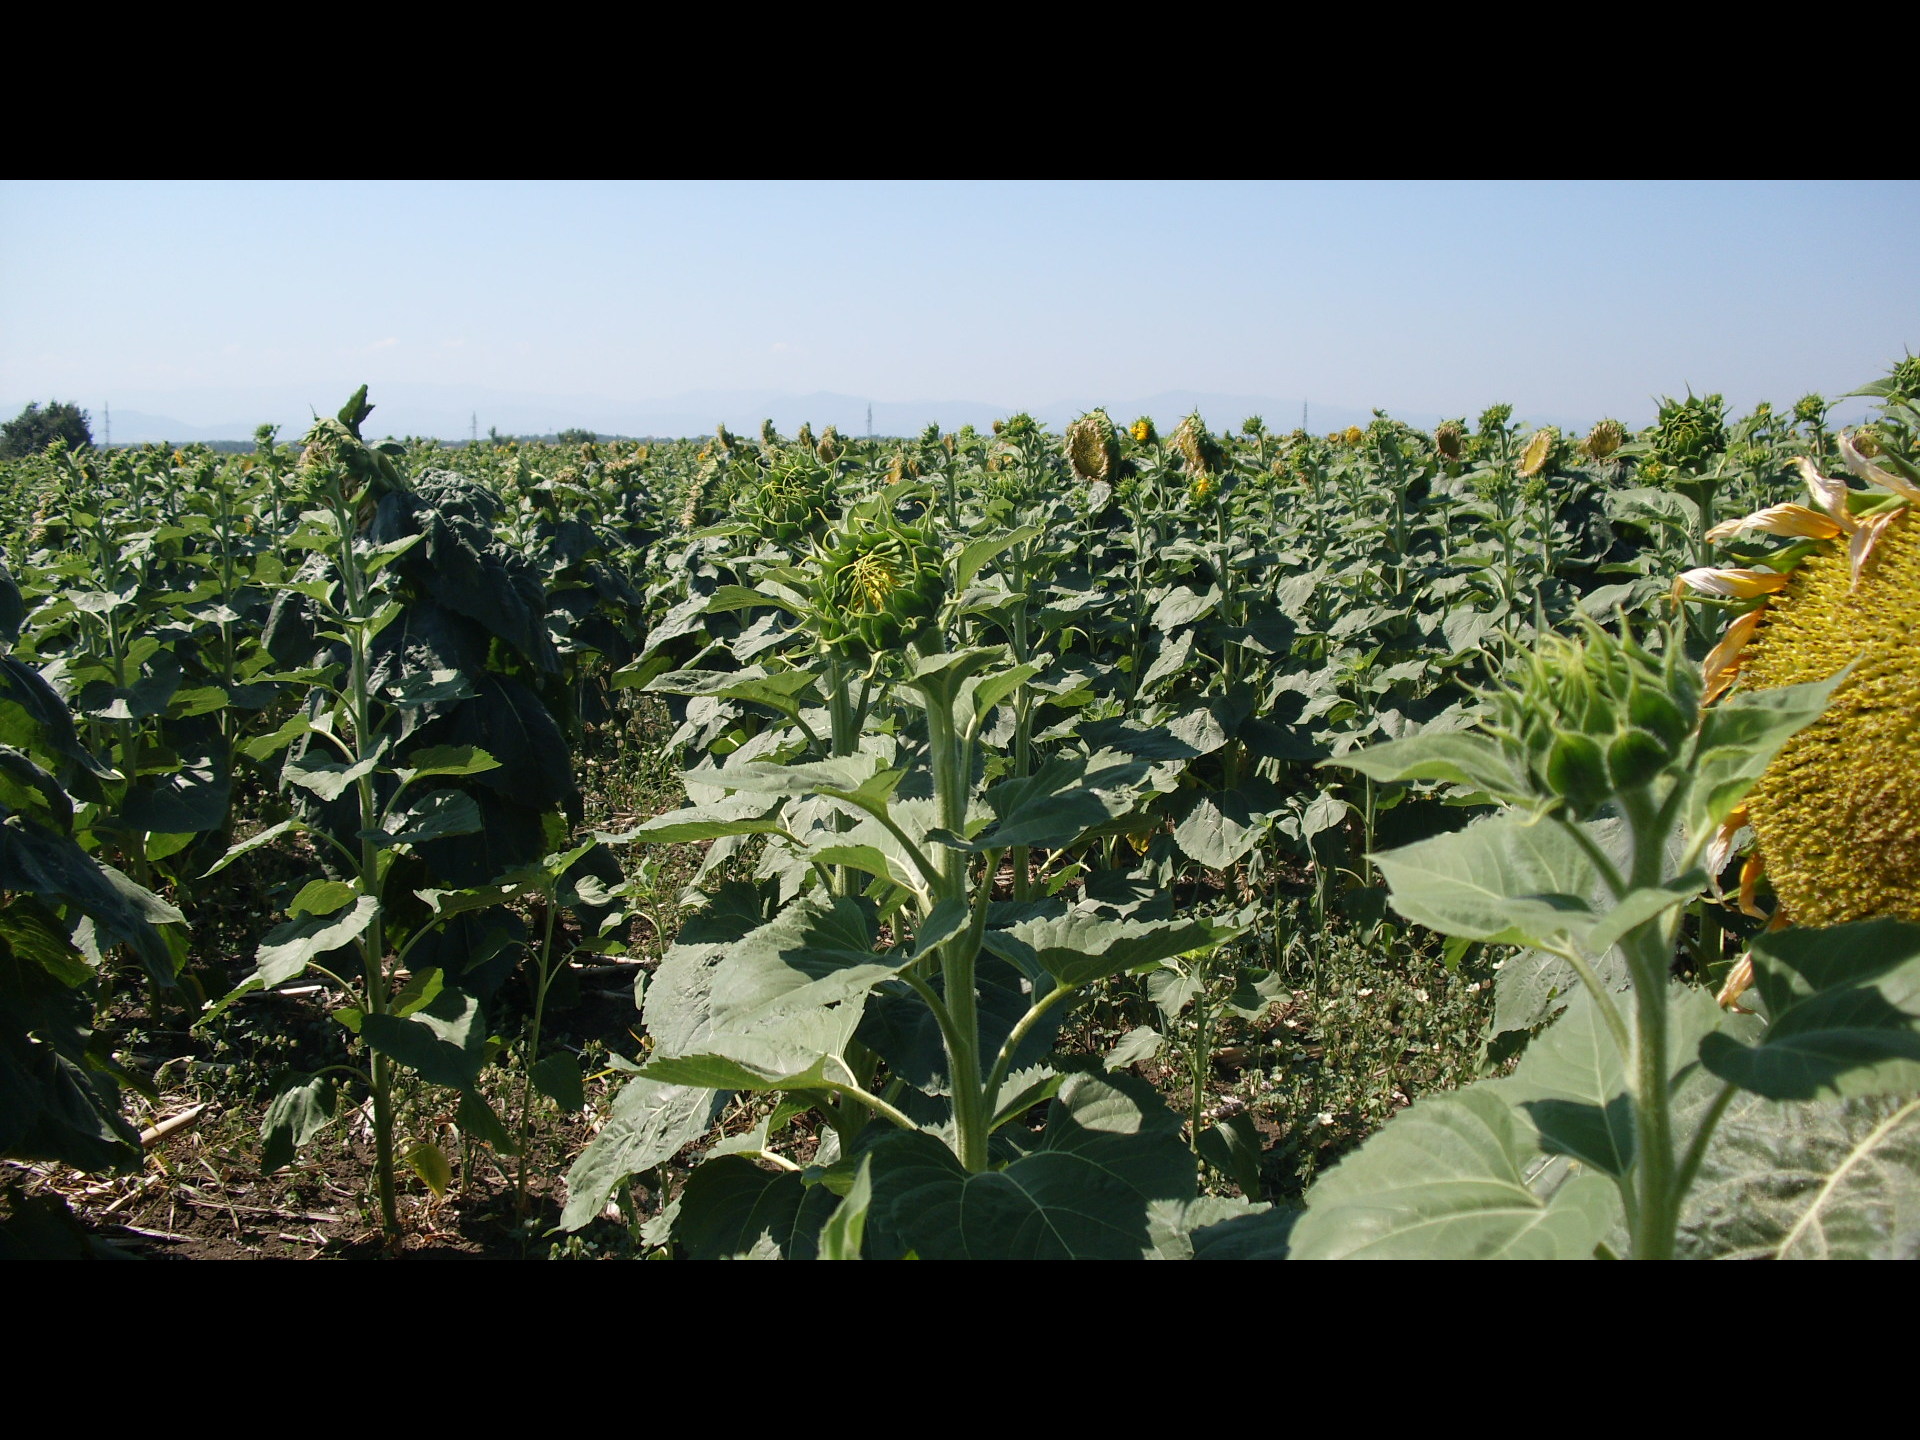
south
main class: Cropland
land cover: Sunflower
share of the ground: > 75 %
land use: Agriculture (excluding fallow land and kitchen gardens)
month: July
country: BG
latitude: 43.8660
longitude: 22.6399
